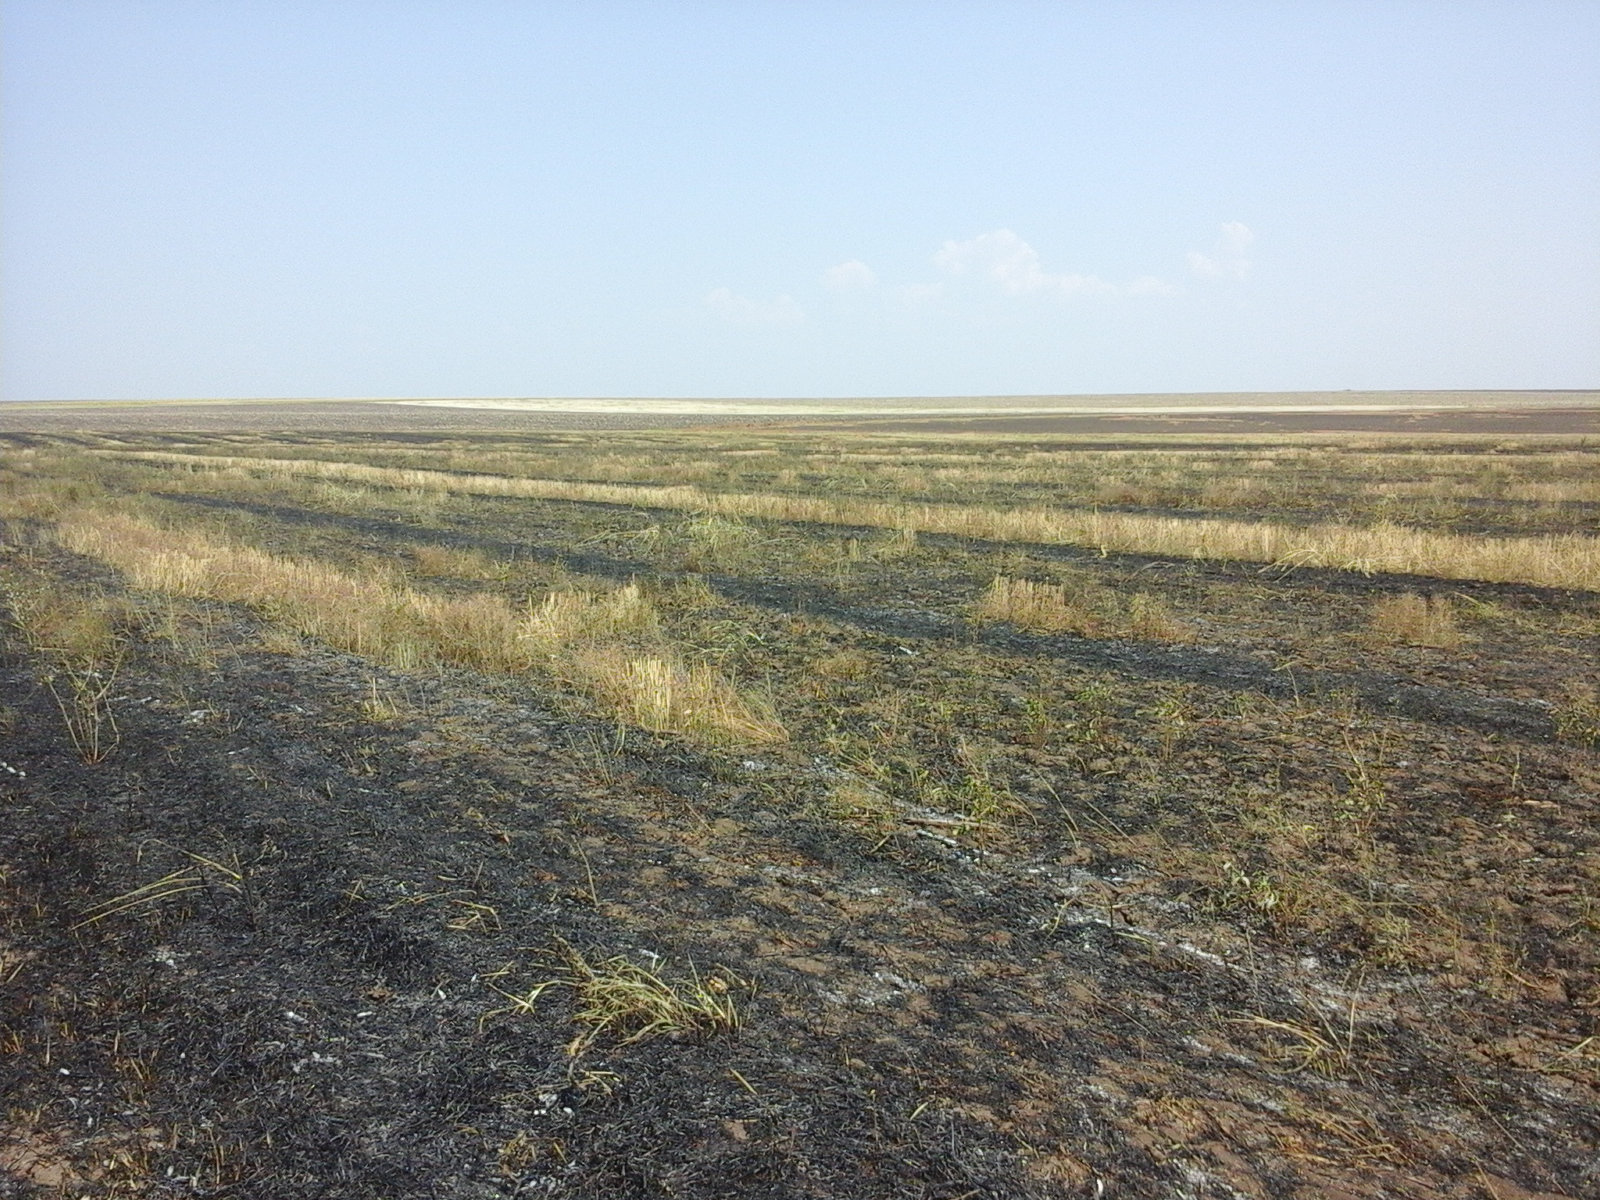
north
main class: Cropland
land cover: Common wheat
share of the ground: 25 - 50 %
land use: Agriculture (excluding fallow land and kitchen gardens)
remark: Burnt area
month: August
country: RO
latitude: 44.1895
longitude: 23.3981
